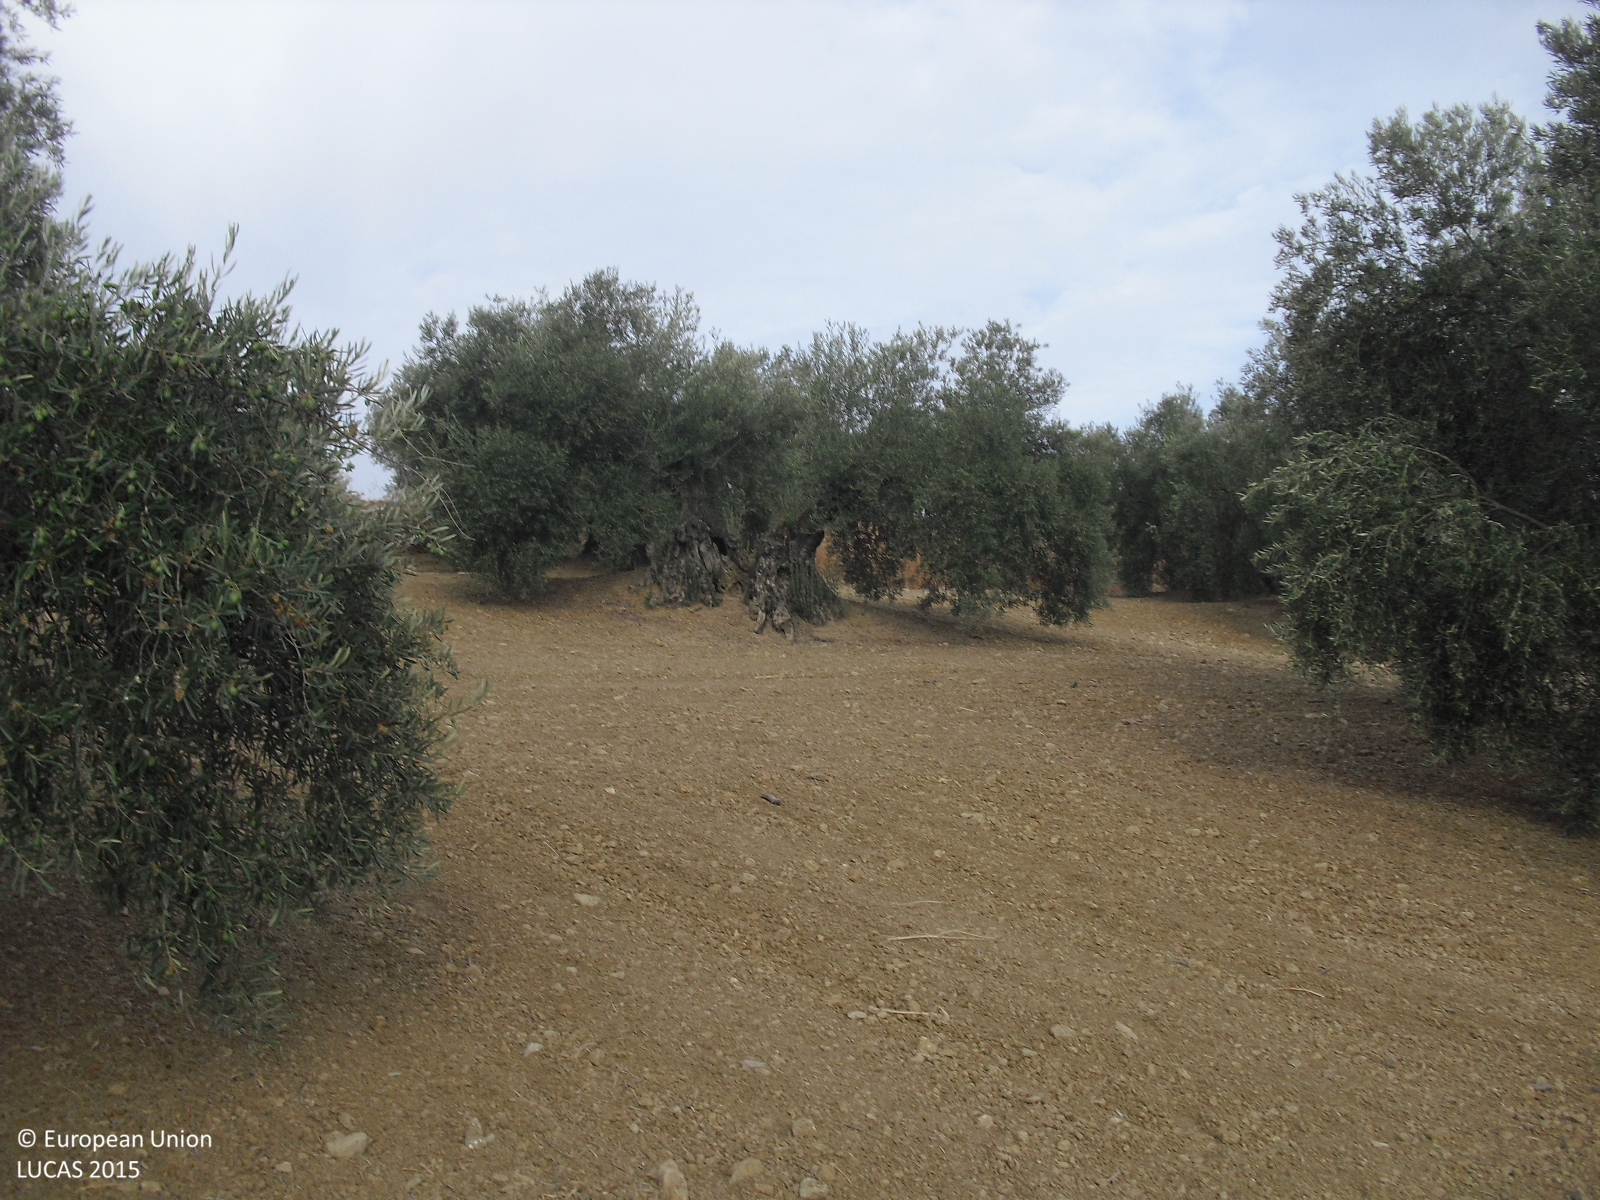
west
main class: Cropland
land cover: Olive groves
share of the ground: 25 - 50 %
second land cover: Other bare soil
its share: > 75 %
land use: Agriculture (excluding fallow land and kitchen gardens)
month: August
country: ES
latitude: 37.3273
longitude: -4.3892
